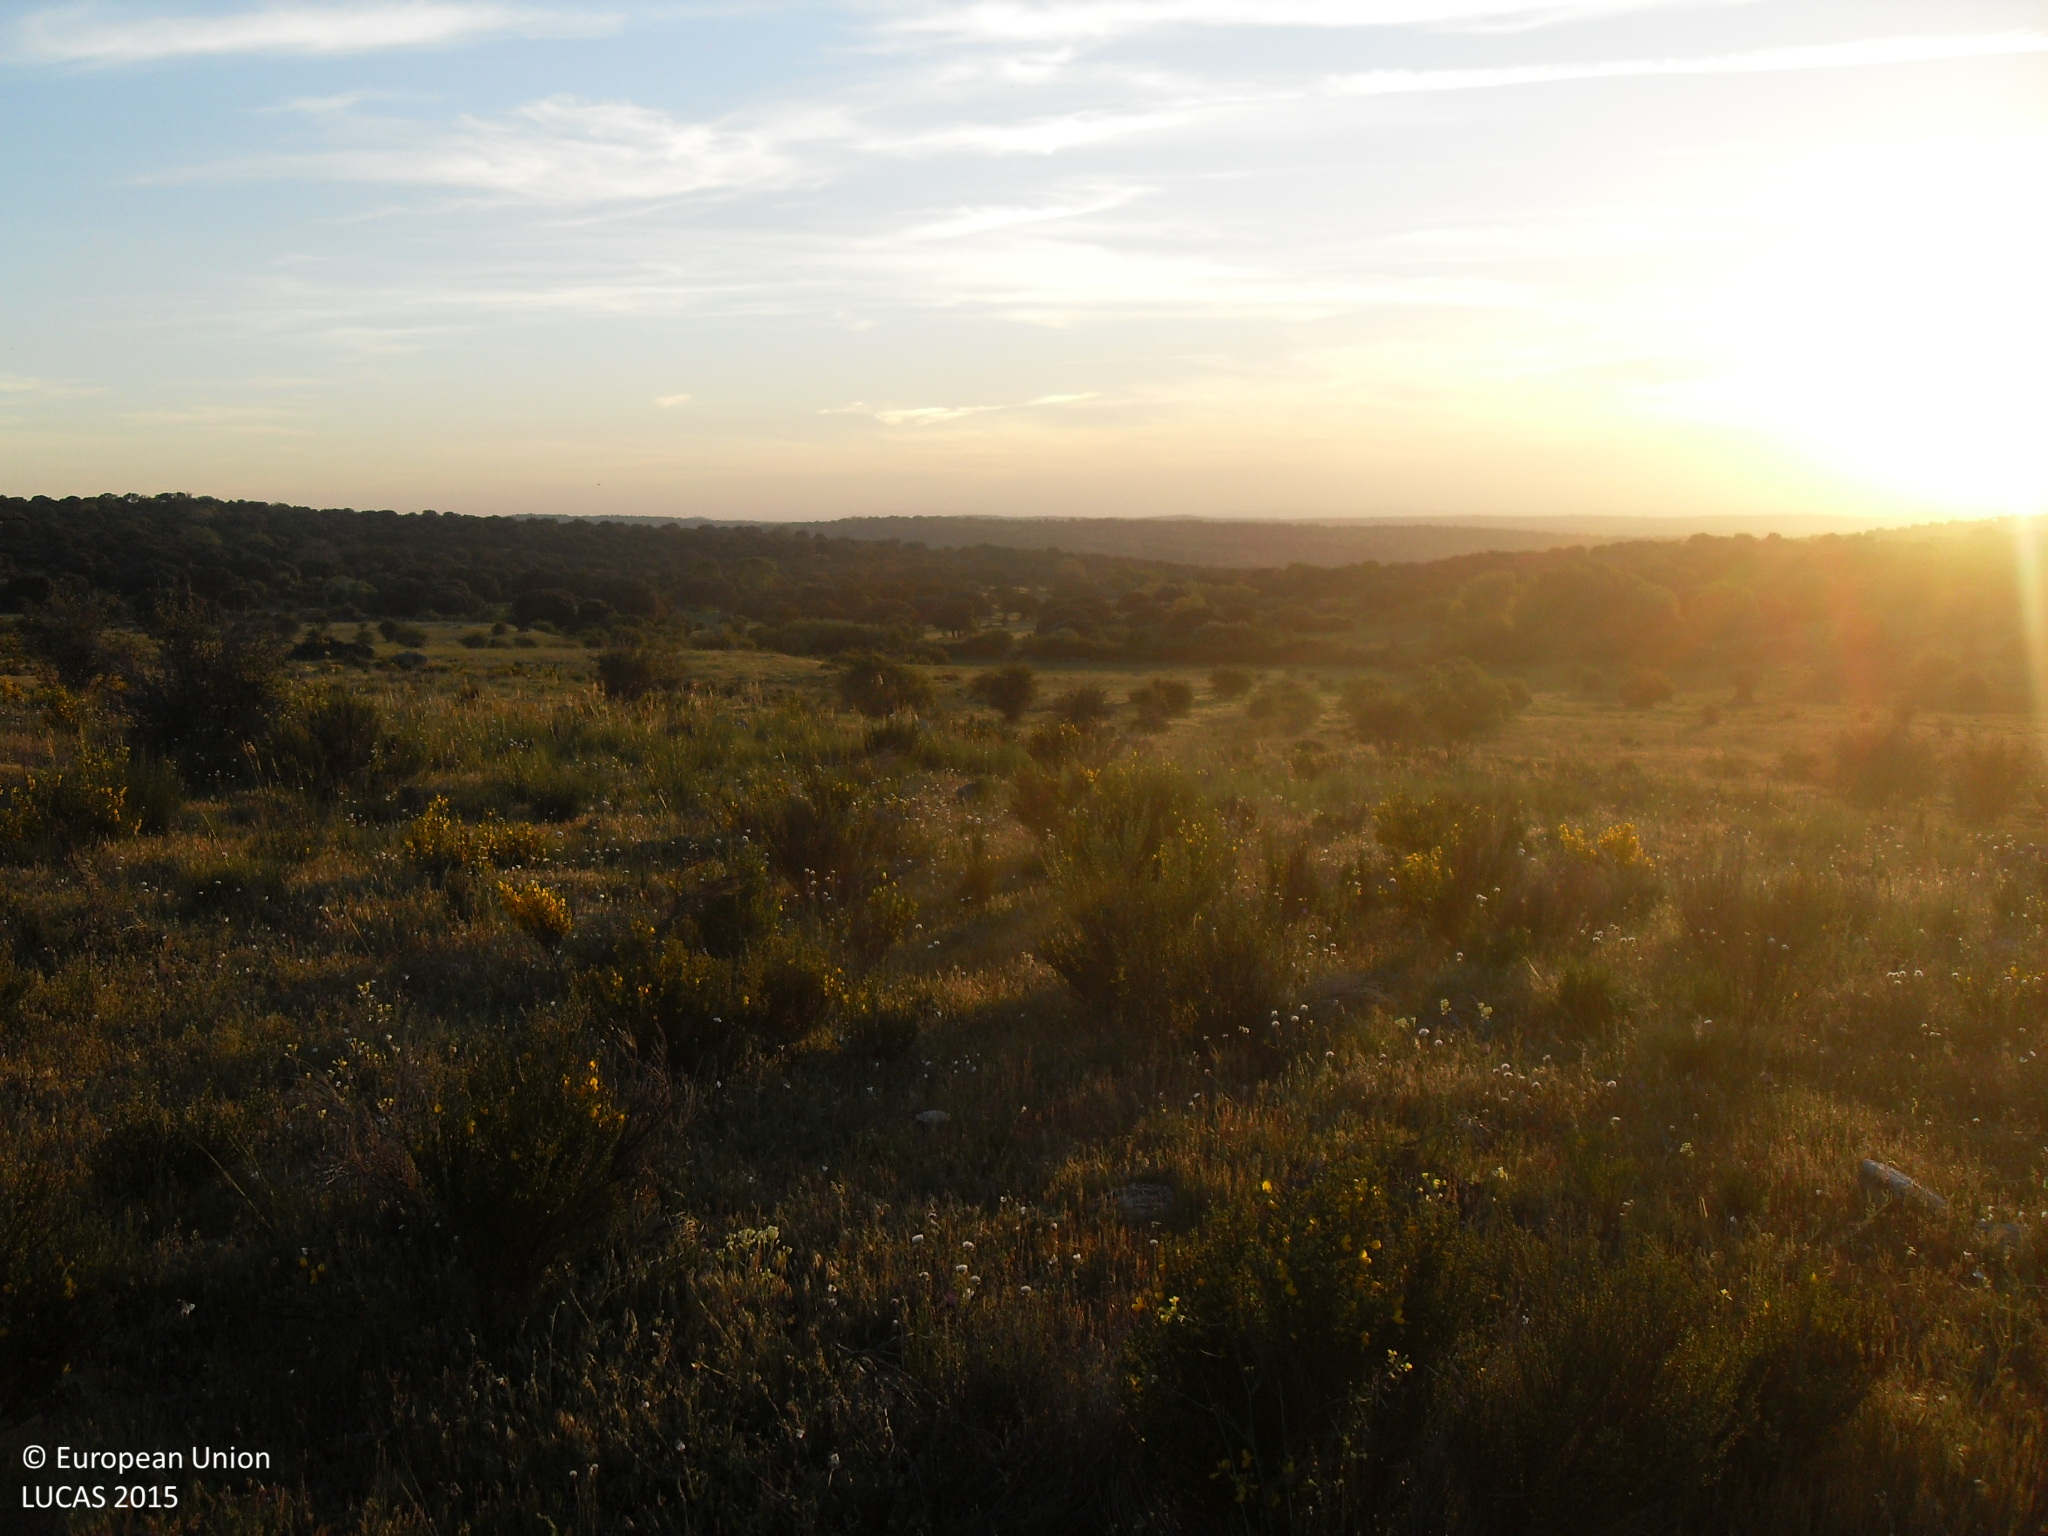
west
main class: Shrubland
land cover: Shrubland without tree cover
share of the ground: > 75 %
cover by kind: shrubs 100 %
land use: Agriculture (excluding fallow land and kitchen gardens)
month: May
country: ES
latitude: 40.6458
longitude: -5.1403
